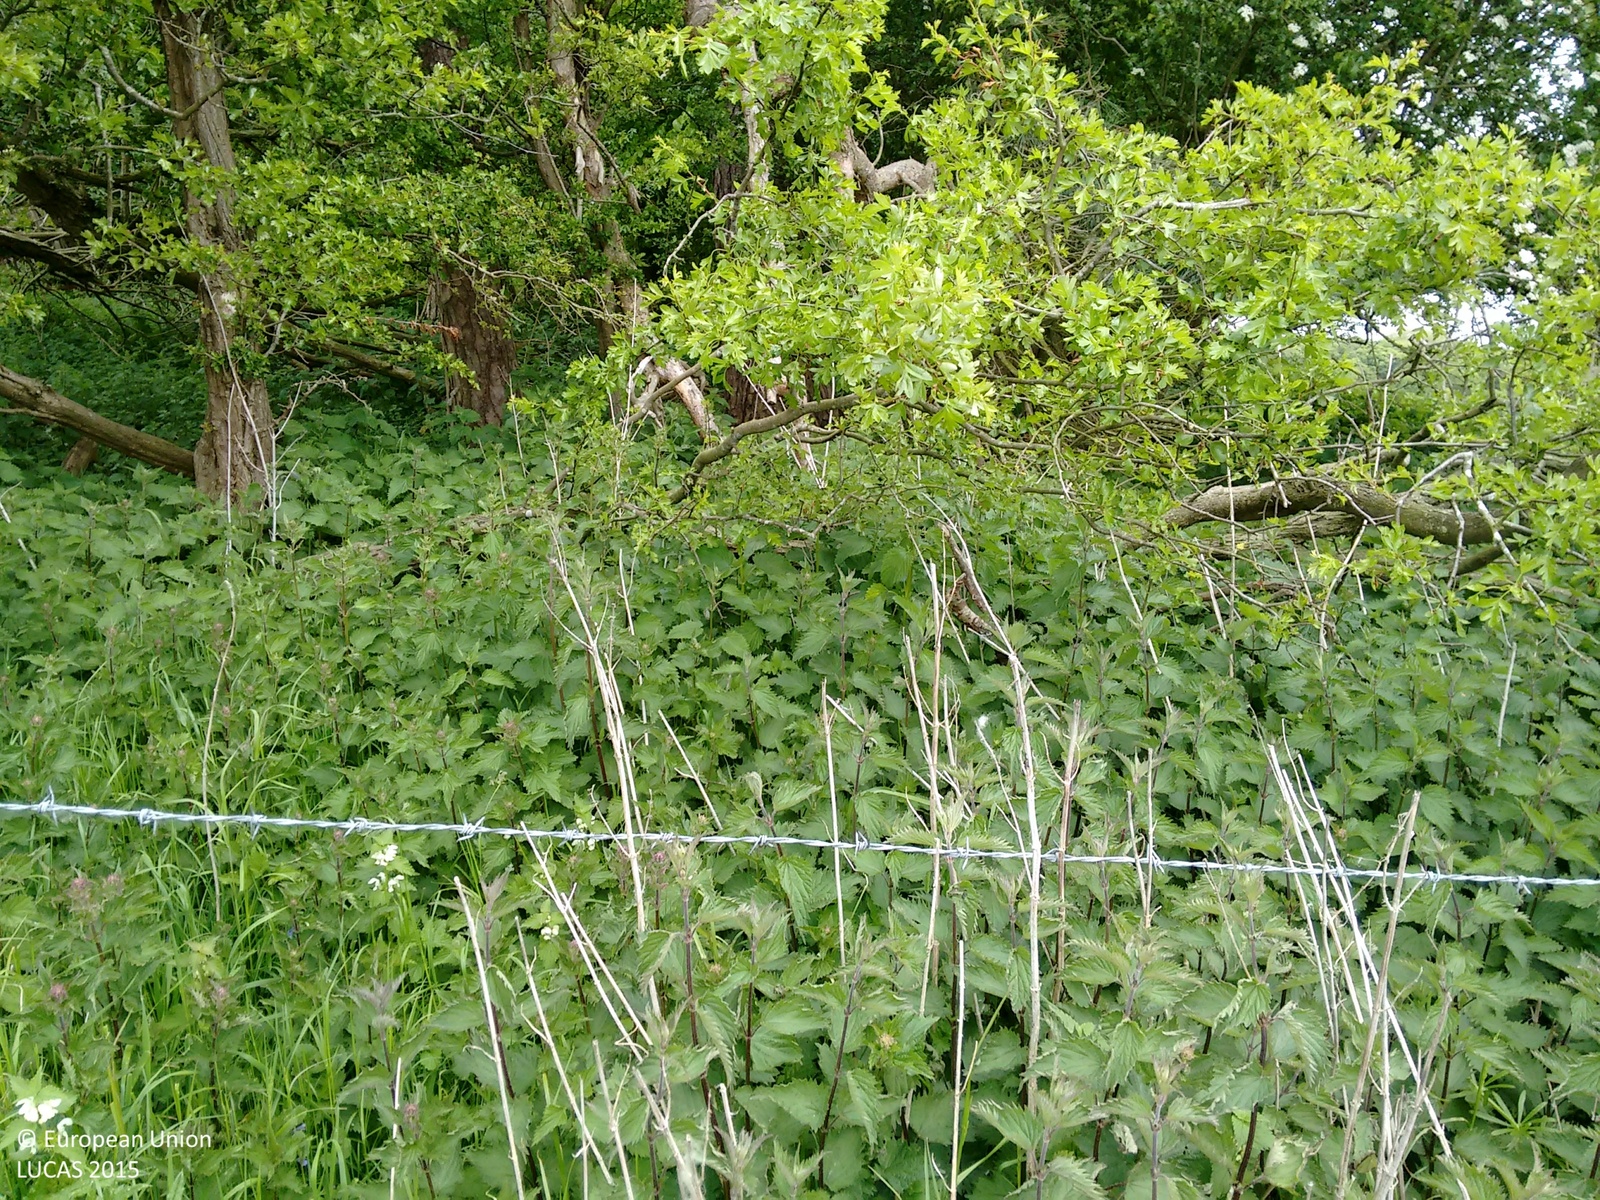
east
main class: Grassland
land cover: Grassland without tree/shrub cover
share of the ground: > 75 %
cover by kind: herbaceous plants 100 %
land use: Agriculture (excluding fallow land and kitchen gardens)
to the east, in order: Grassland without tree/shrub cover; Broadleaved woodland; Fences; Grassland with sparse tree/shrub cover; Fences; Grassland without tree/shrub cover
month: May
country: GB
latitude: 52.1526
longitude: -1.4061
